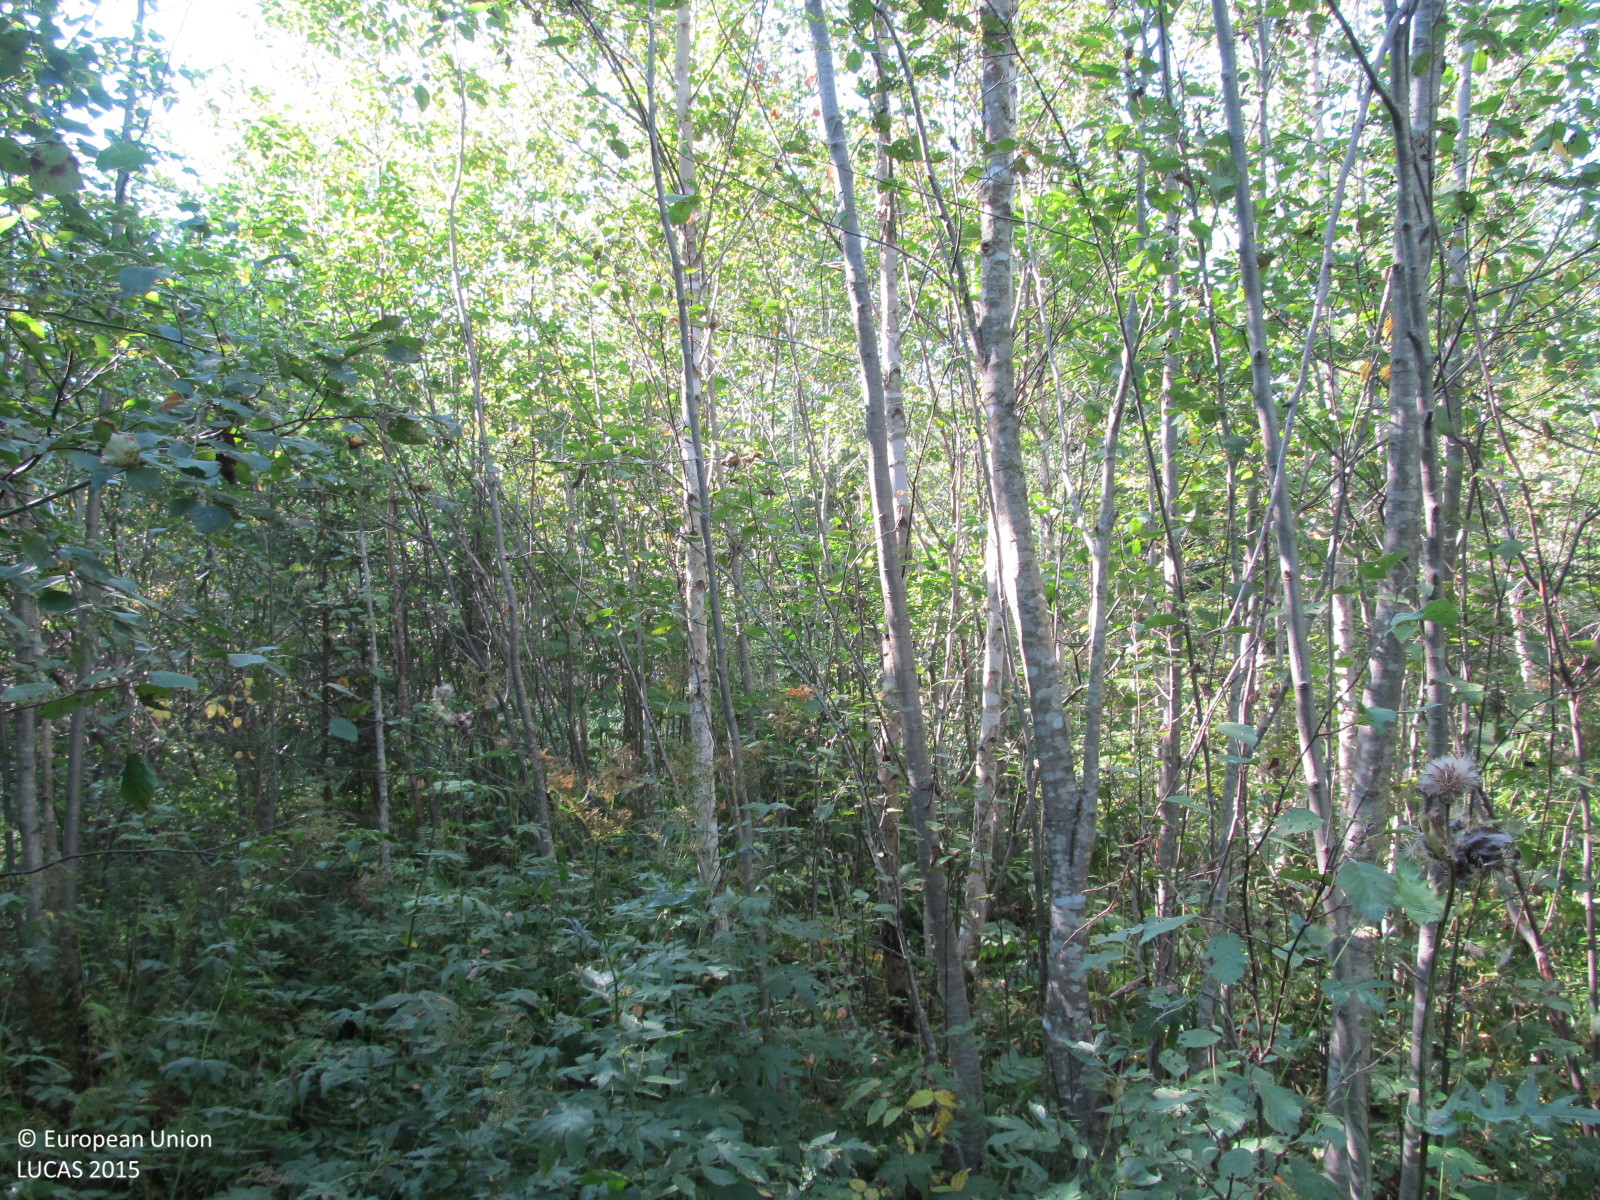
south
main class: Woodland
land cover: Broadleaved woodland
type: non-riverine alder, birch or aspen forest
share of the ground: > 75 %
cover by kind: broadleaved forest trees 80 %, herbaceous plants 20 %
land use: Forestry
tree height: < 5 m
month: August
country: LT
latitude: 55.7300
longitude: 23.1124
